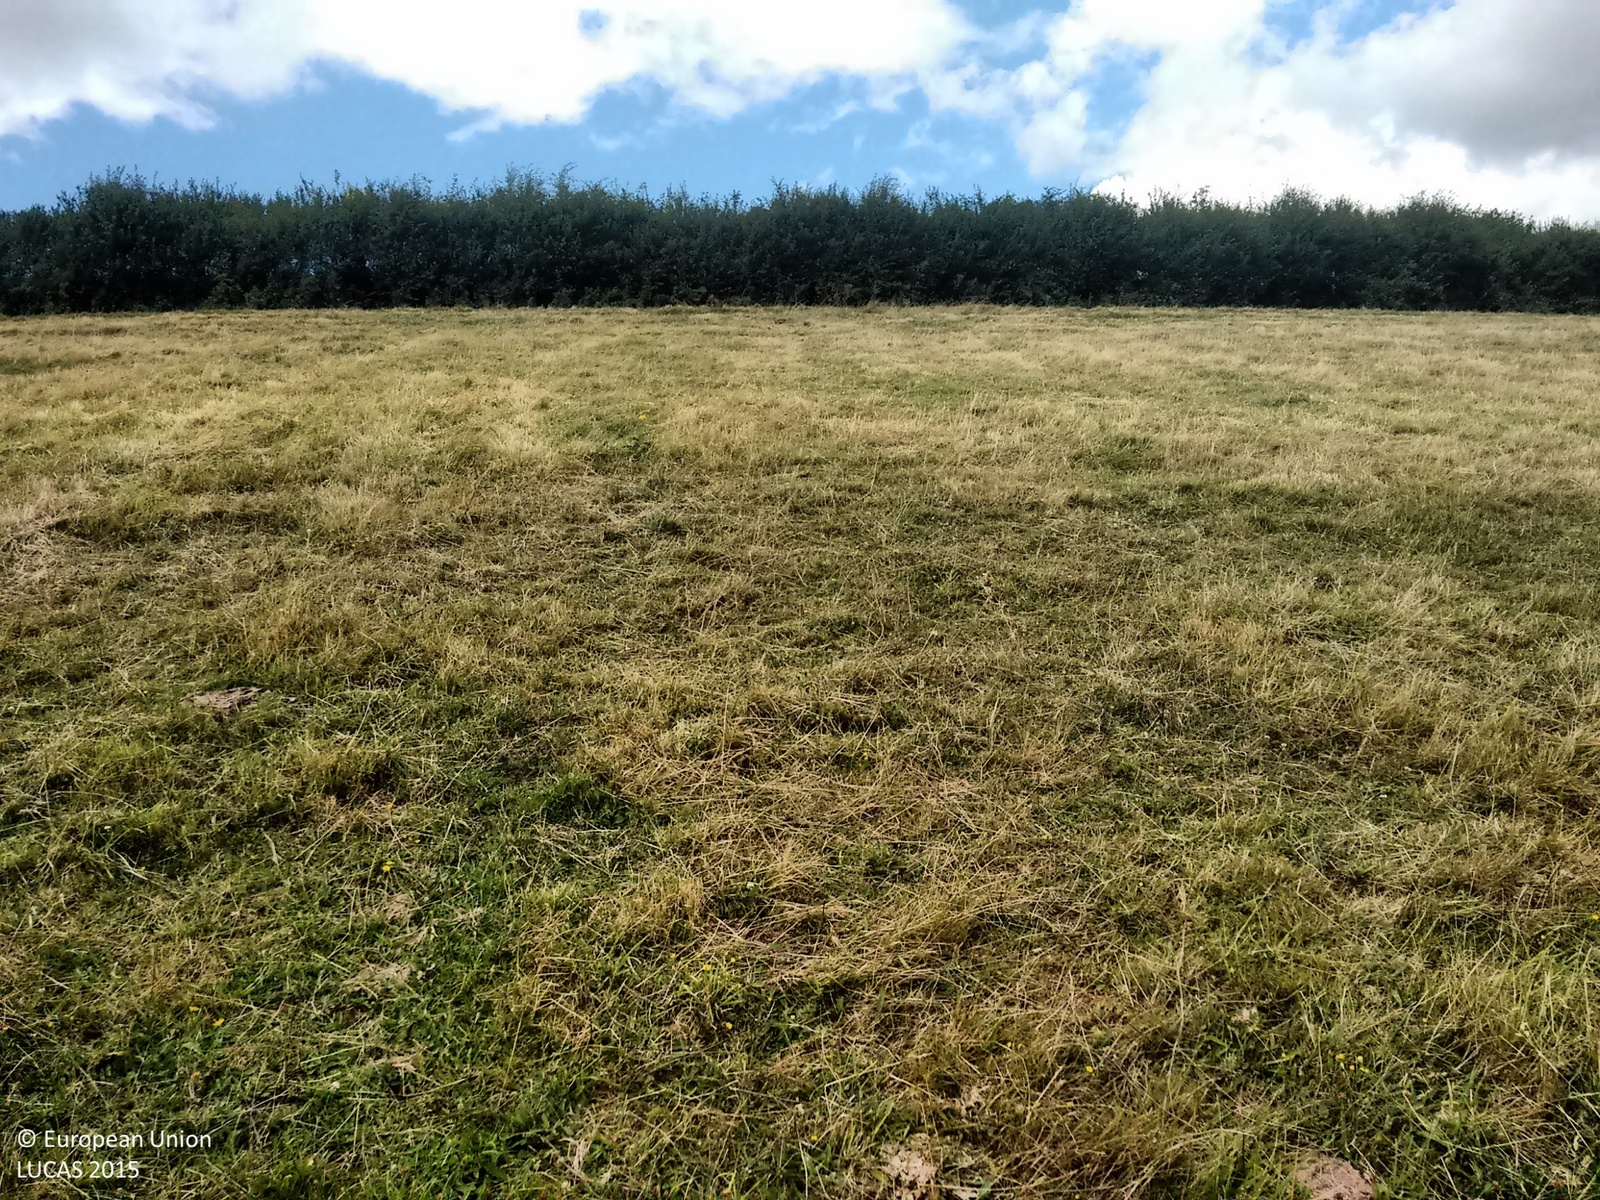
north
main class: Grassland
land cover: Grassland without tree/shrub cover
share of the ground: > 75 %
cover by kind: herbaceous plants 100 %
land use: Agriculture (excluding fallow land and kitchen gardens)
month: July
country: GB
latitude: 50.3825
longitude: -3.6290
